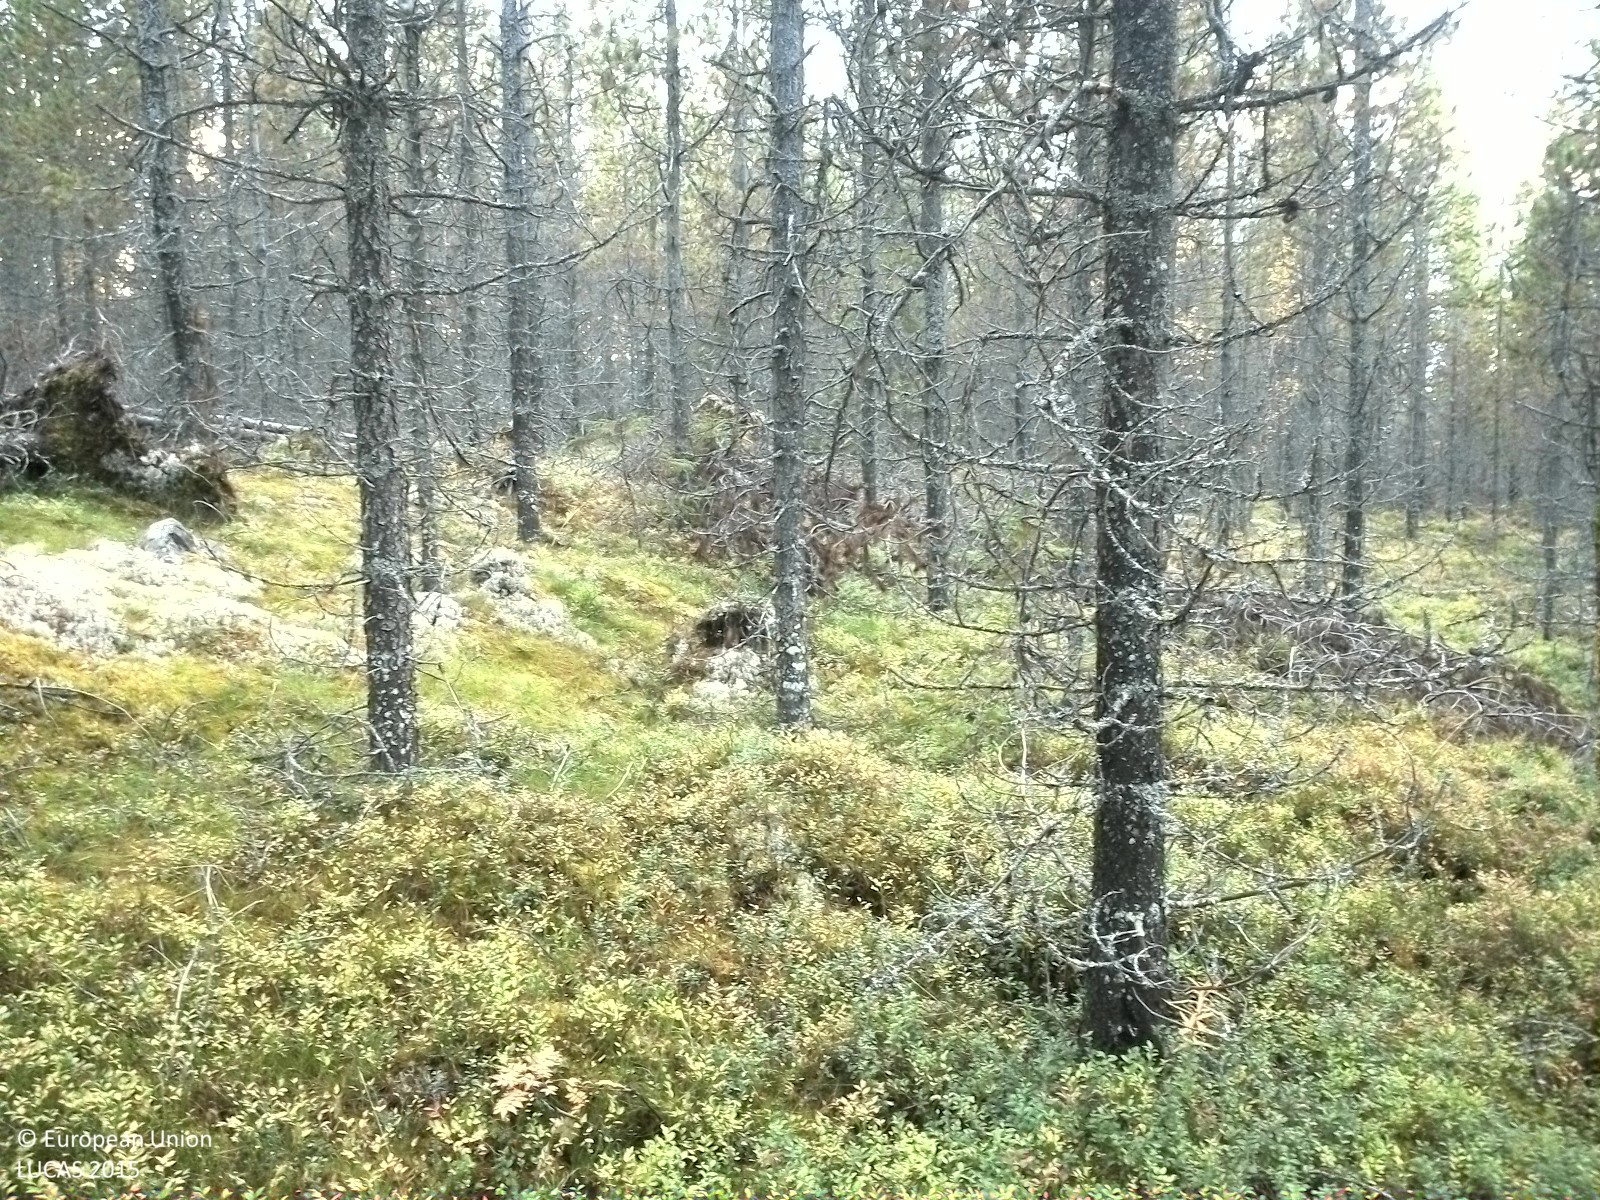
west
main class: Woodland
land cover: Pine dominated coniferous woodland
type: exotic forest
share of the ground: > 75 %
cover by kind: coniferous forest trees 75 %, shrubs 15 %, herbaceous plants 5 %, lichens and mosses 5 %
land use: Forestry
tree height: > 5 m
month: September
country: SE
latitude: 62.2379
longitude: 16.0423
